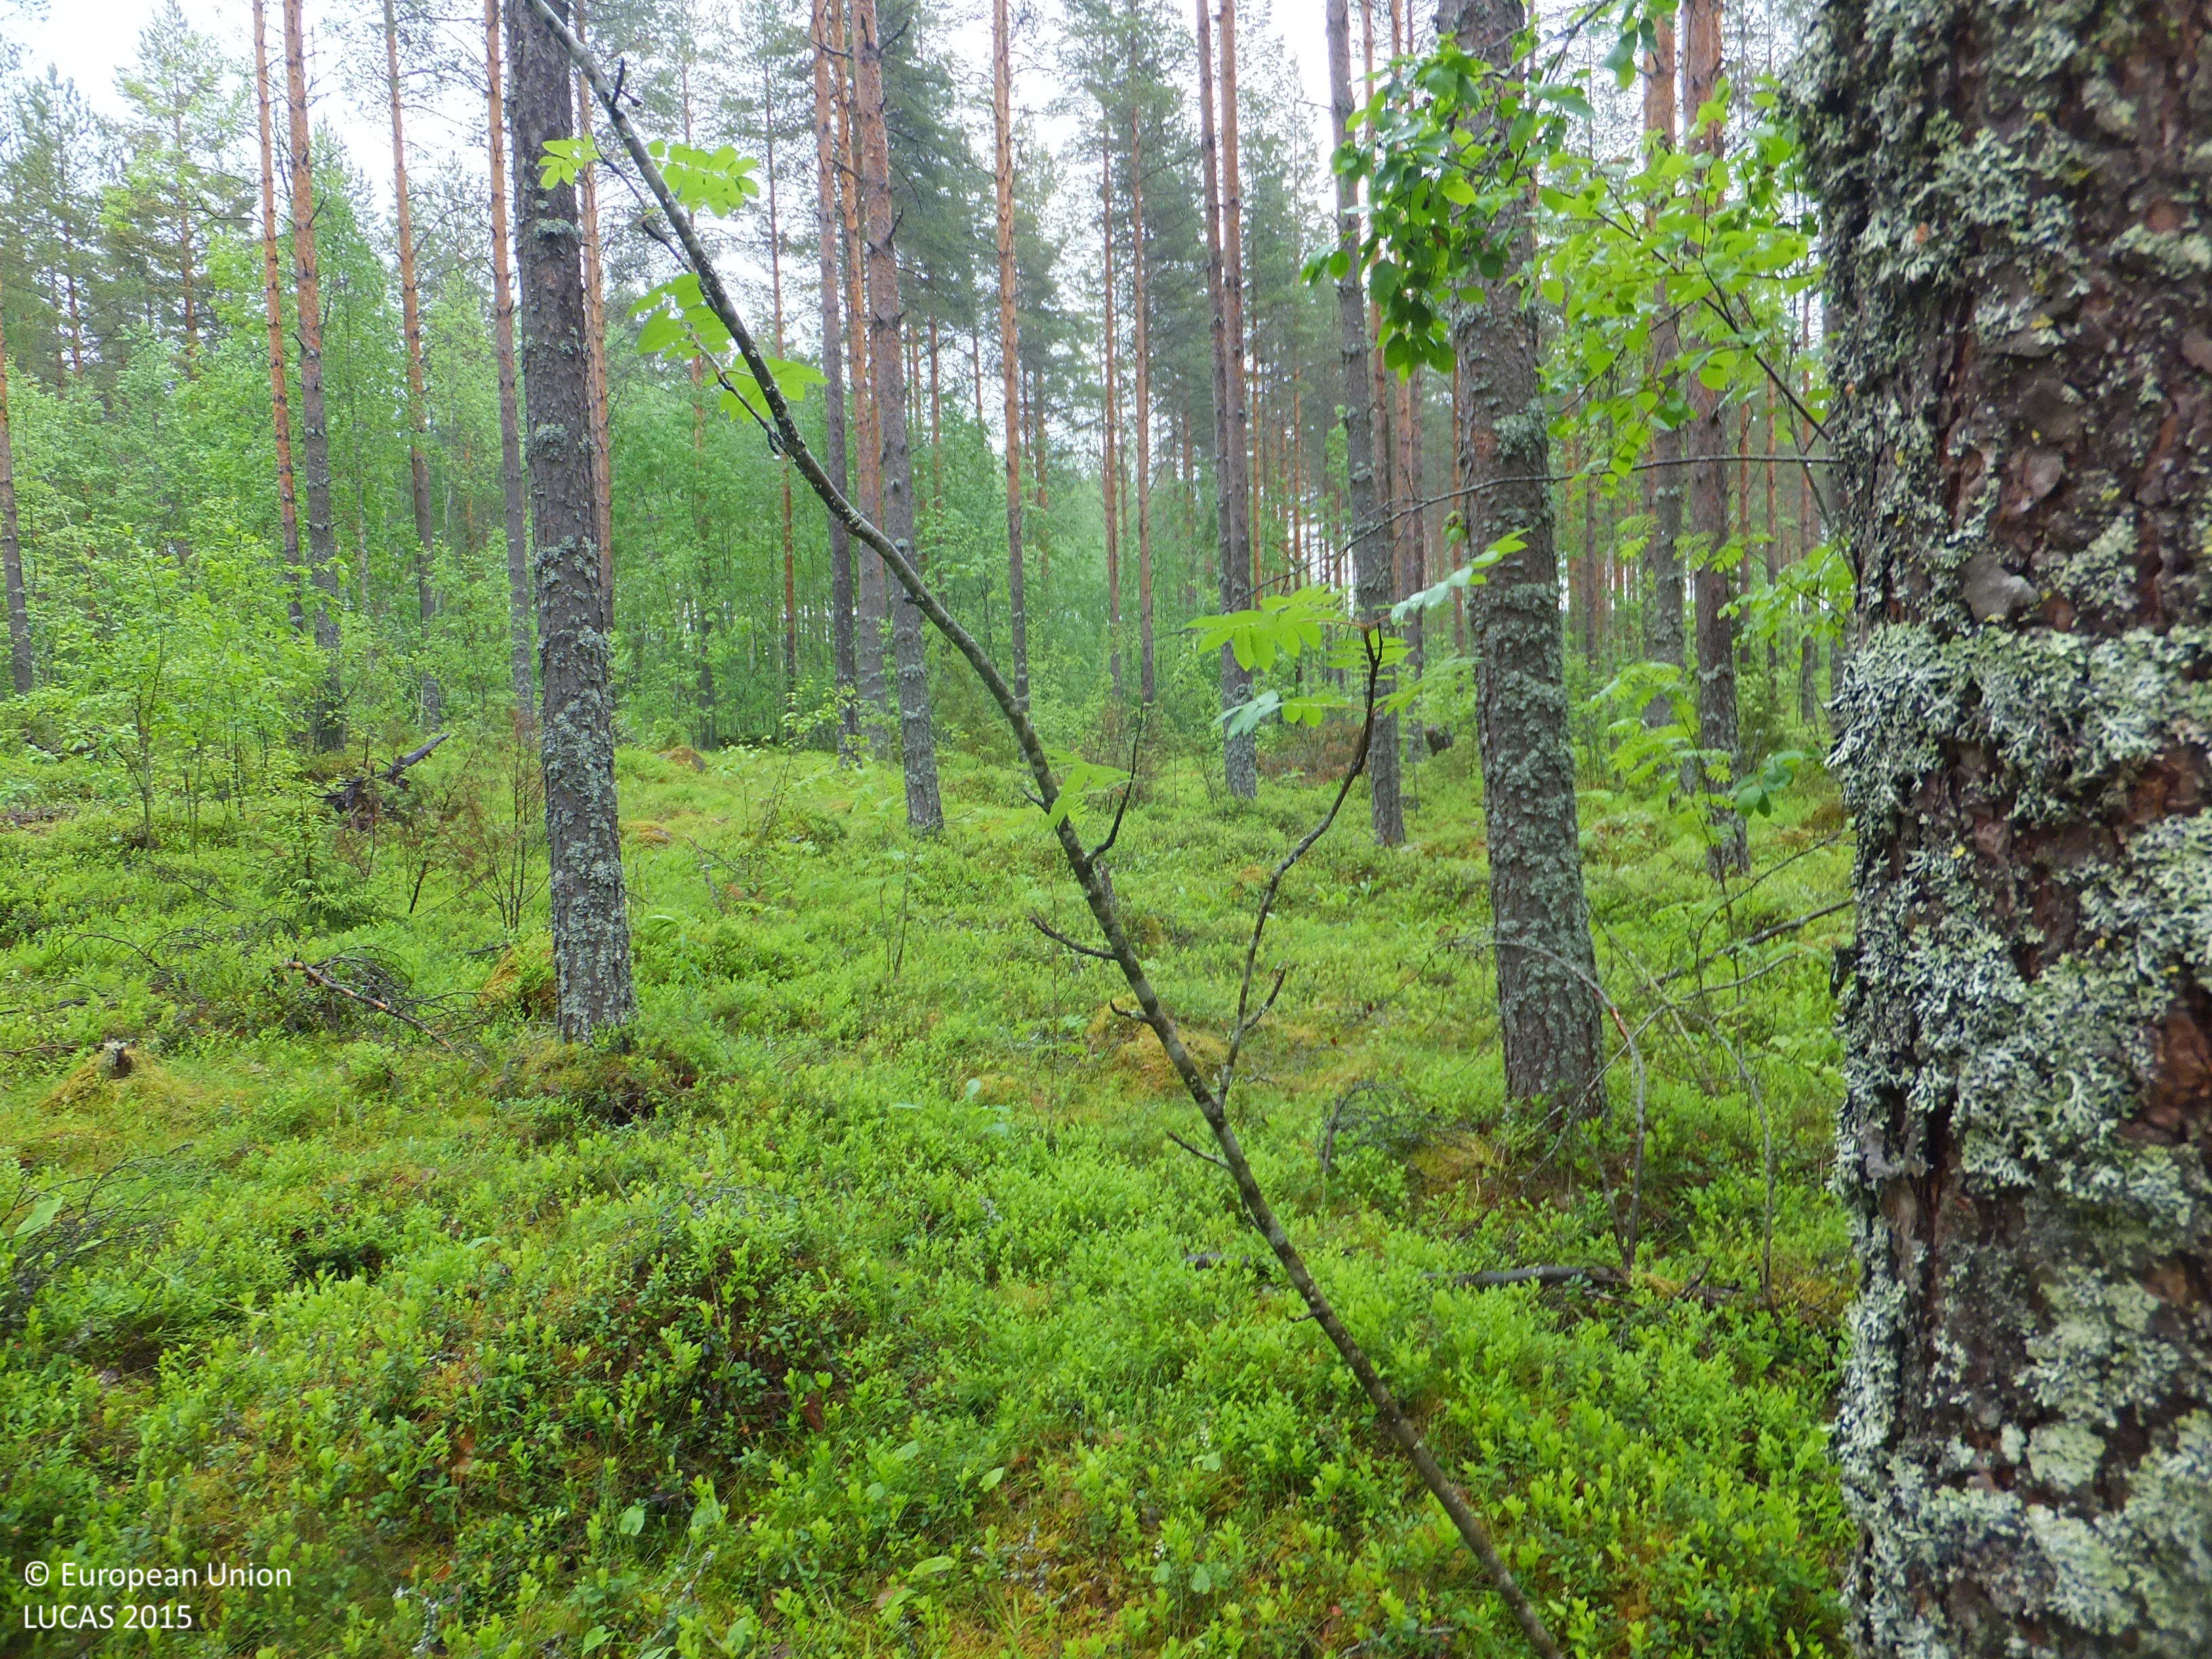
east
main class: Woodland
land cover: Pine dominated coniferous woodland
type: boreal forest
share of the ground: > 75 %
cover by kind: coniferous forest trees 80 %, shrubs 10 %, broadleaved forest trees 5 %, lichens and mosses 5 %
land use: Forestry
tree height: > 5 m
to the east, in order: Pine dominated coniferous woodland; Pine dominated mixed woodland; Ditches and canals; Grass margins; Paved roads, cycling and walking lanes; Grass margins; Ditches and canals; Pine dominated mixed woodland; Grassland with sparse tree/shrub cover; Tracks; Pine dominated mixed woodland; Broadleaved woodland
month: June
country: FI
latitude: 63.3296
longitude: 24.8050
